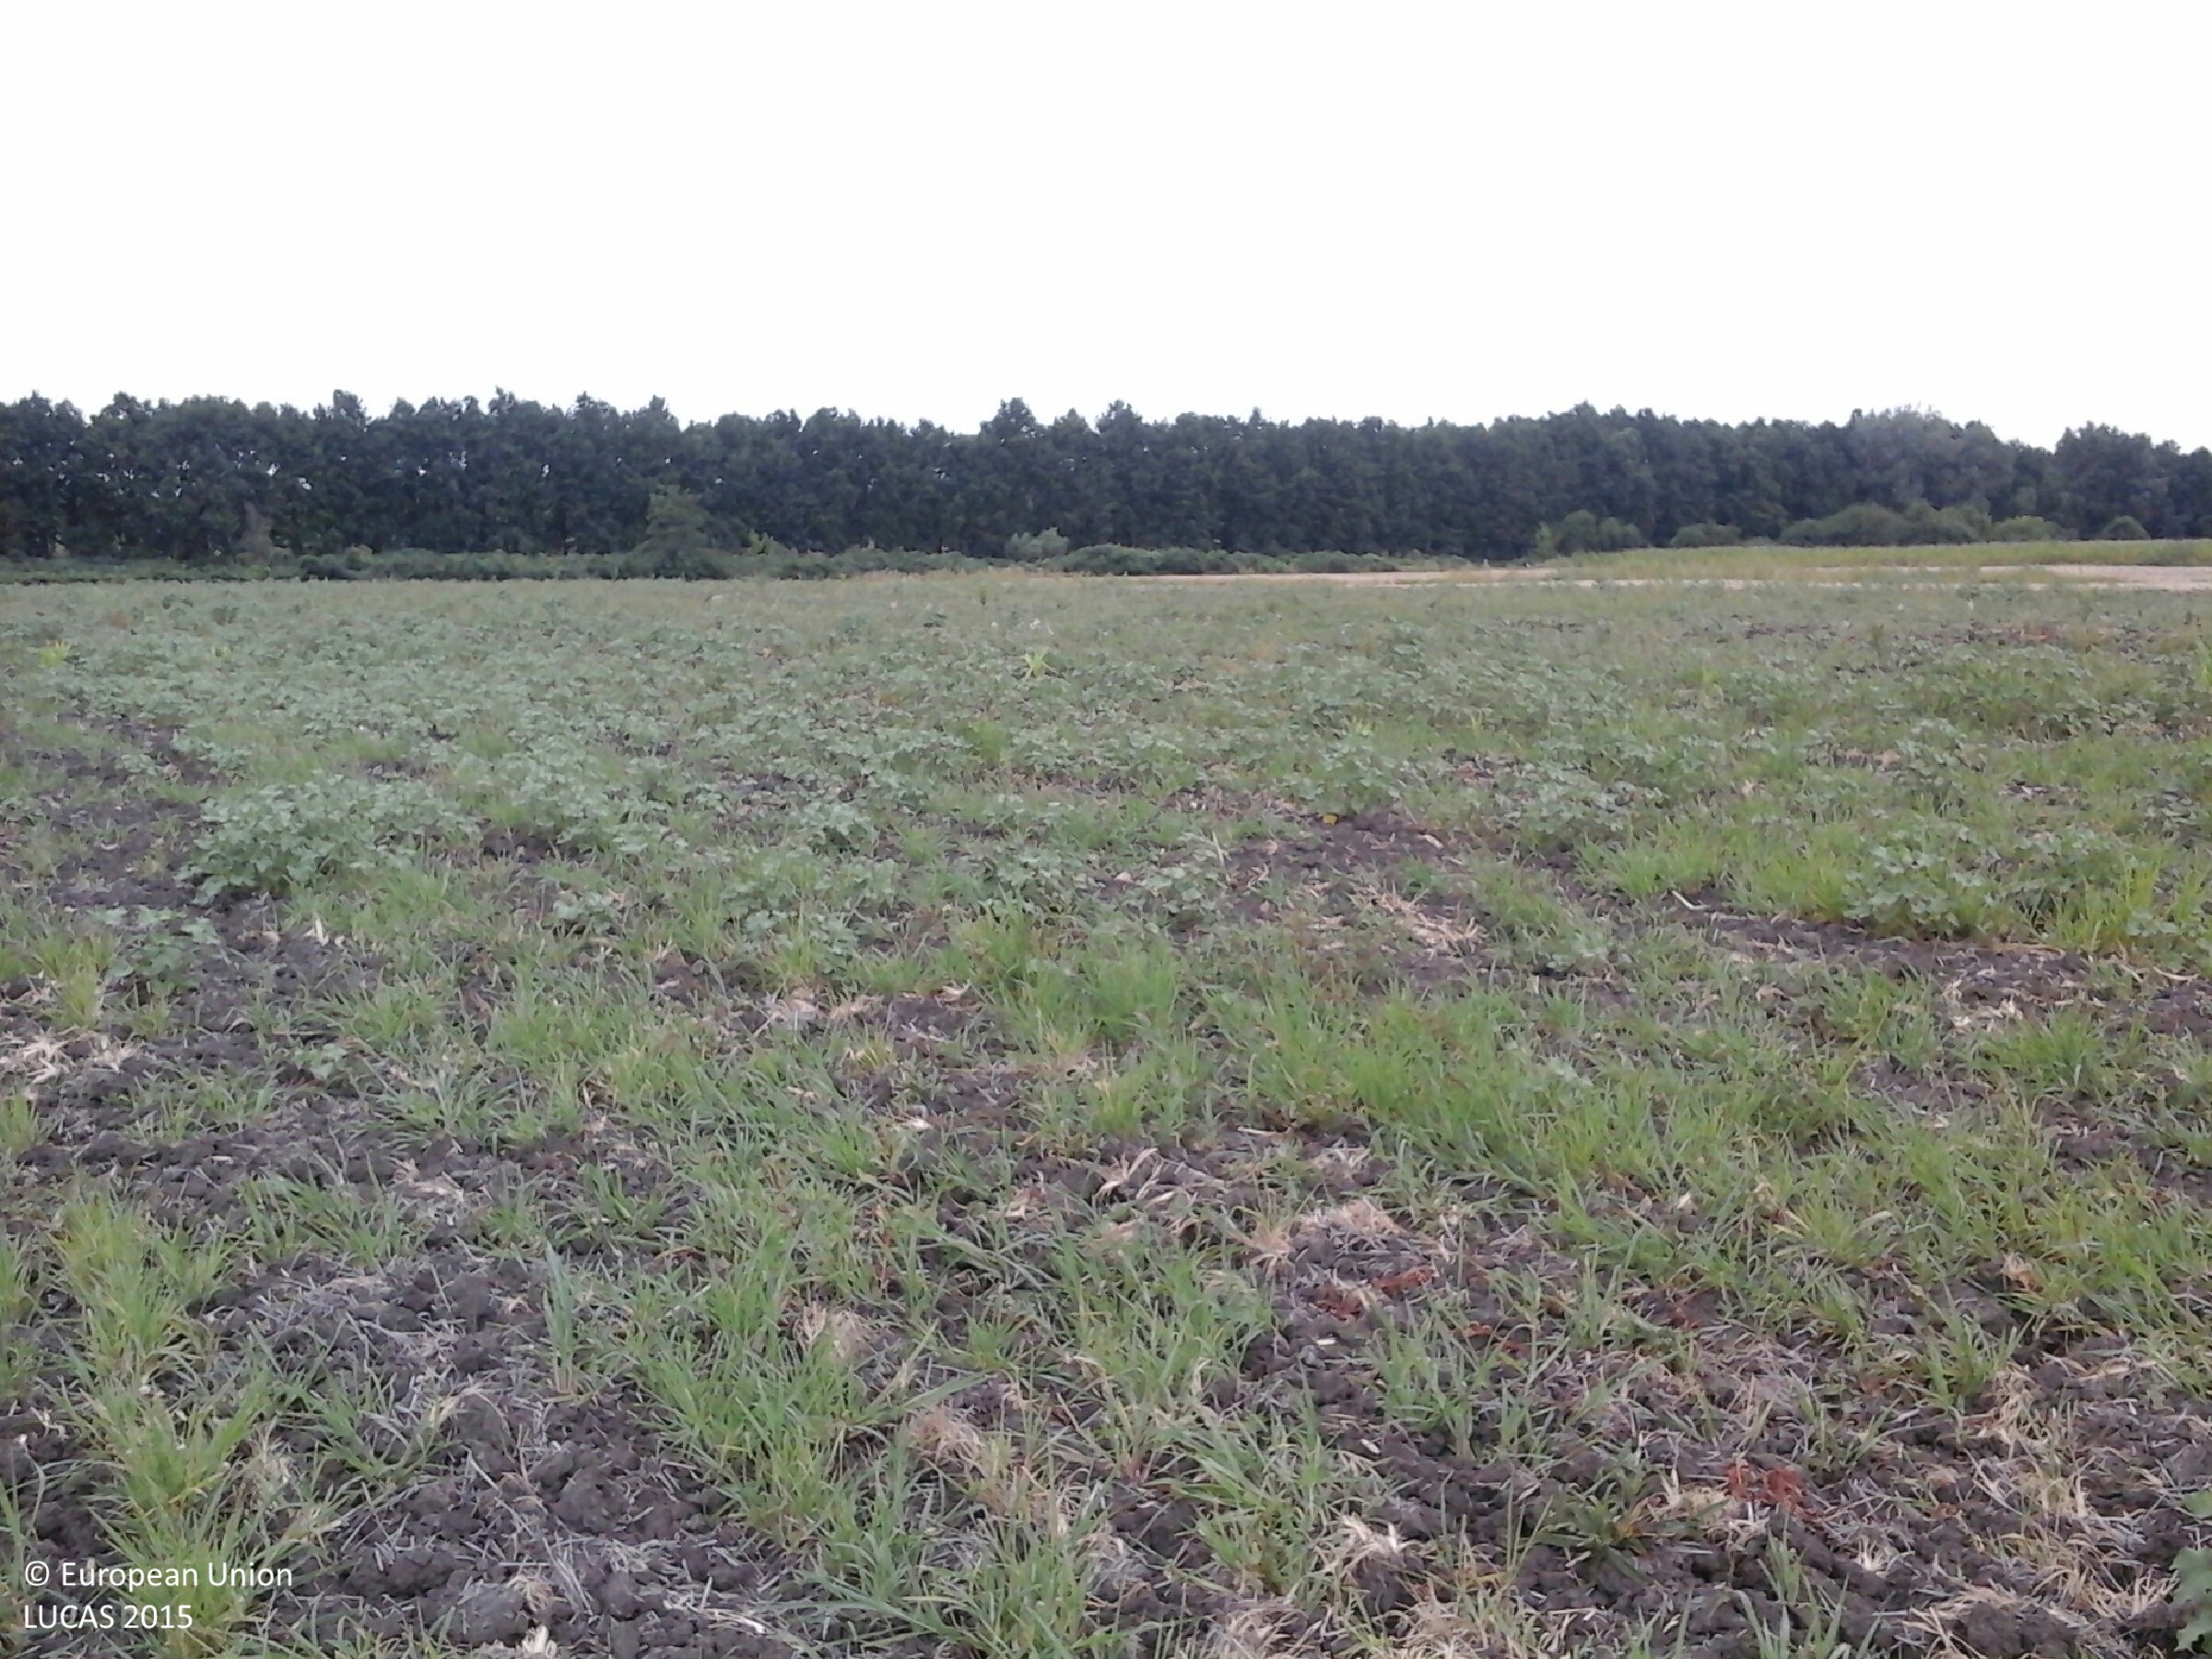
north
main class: Cropland
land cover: Common wheat
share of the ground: < 10 %
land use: Agriculture (excluding fallow land and kitchen gardens)
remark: Harvested field
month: July
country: HU
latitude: 47.5733
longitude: 20.7084
